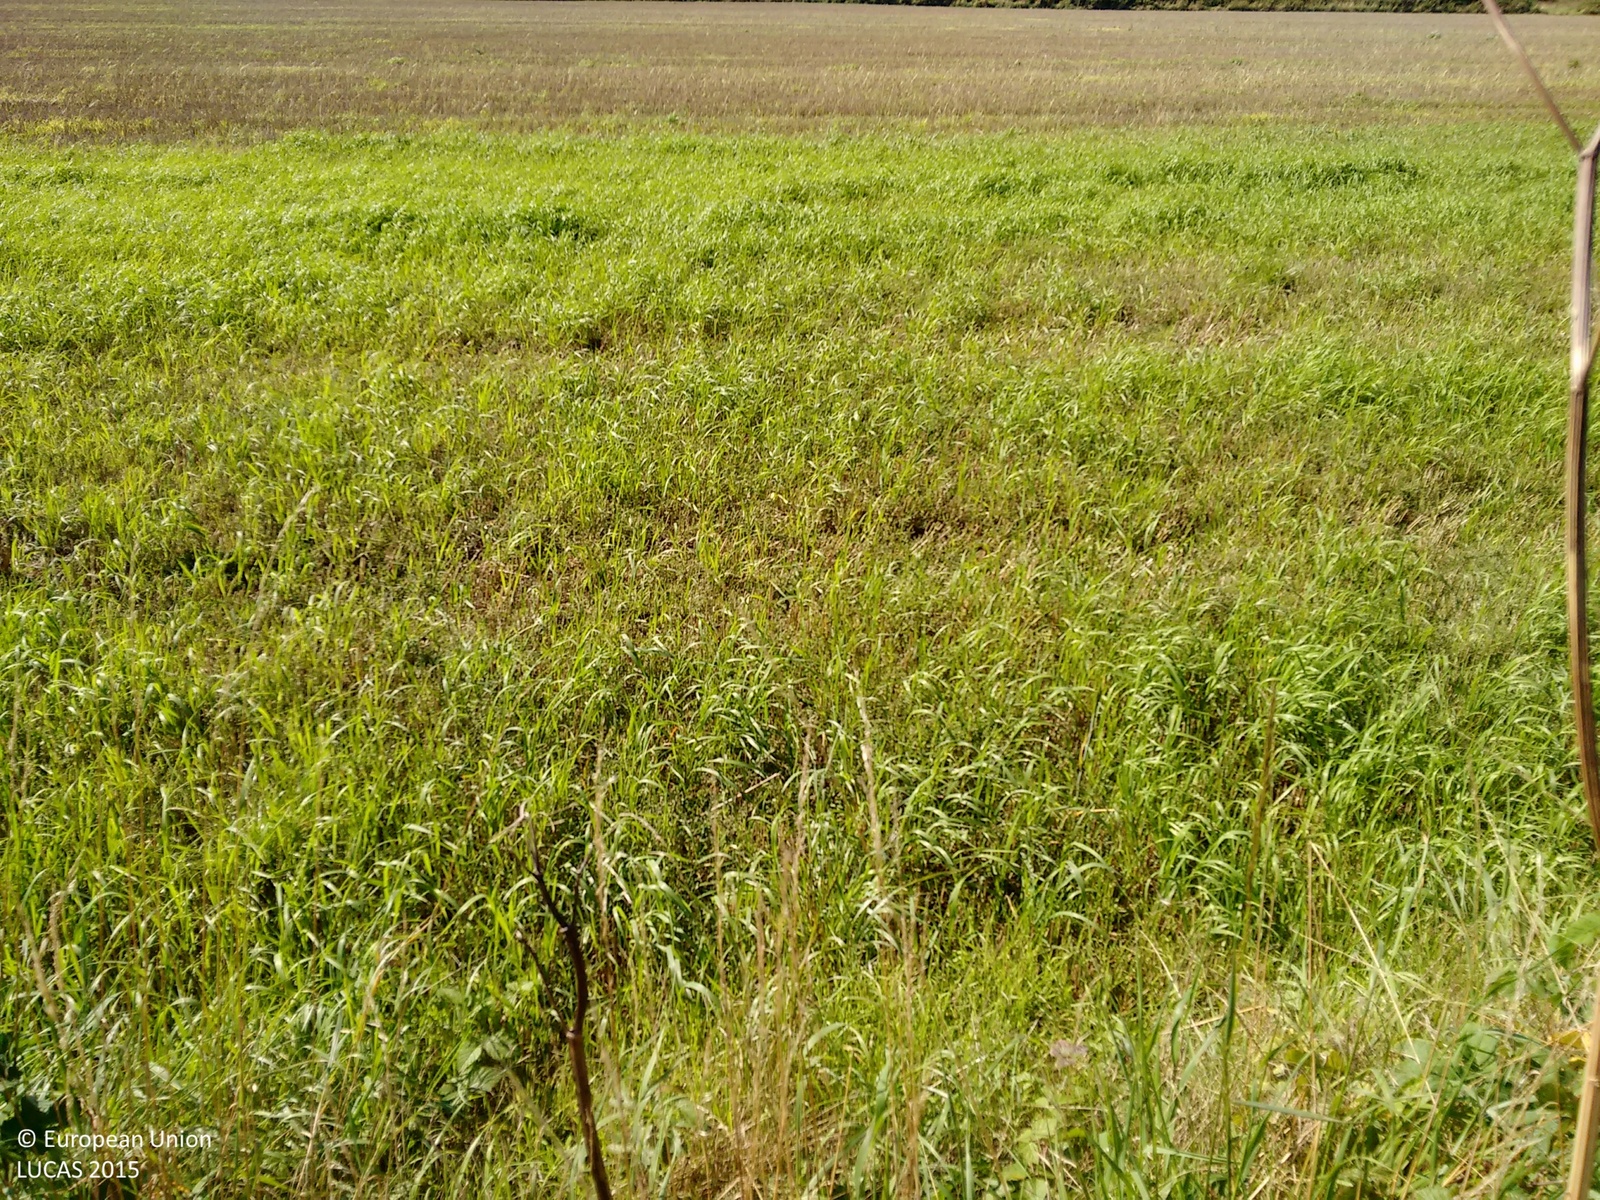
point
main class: Cropland
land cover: Common wheat
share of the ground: > 75 %
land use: Agriculture (excluding fallow land and kitchen gardens)
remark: Harvested field
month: September
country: GB
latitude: 52.5659
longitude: 0.8436
